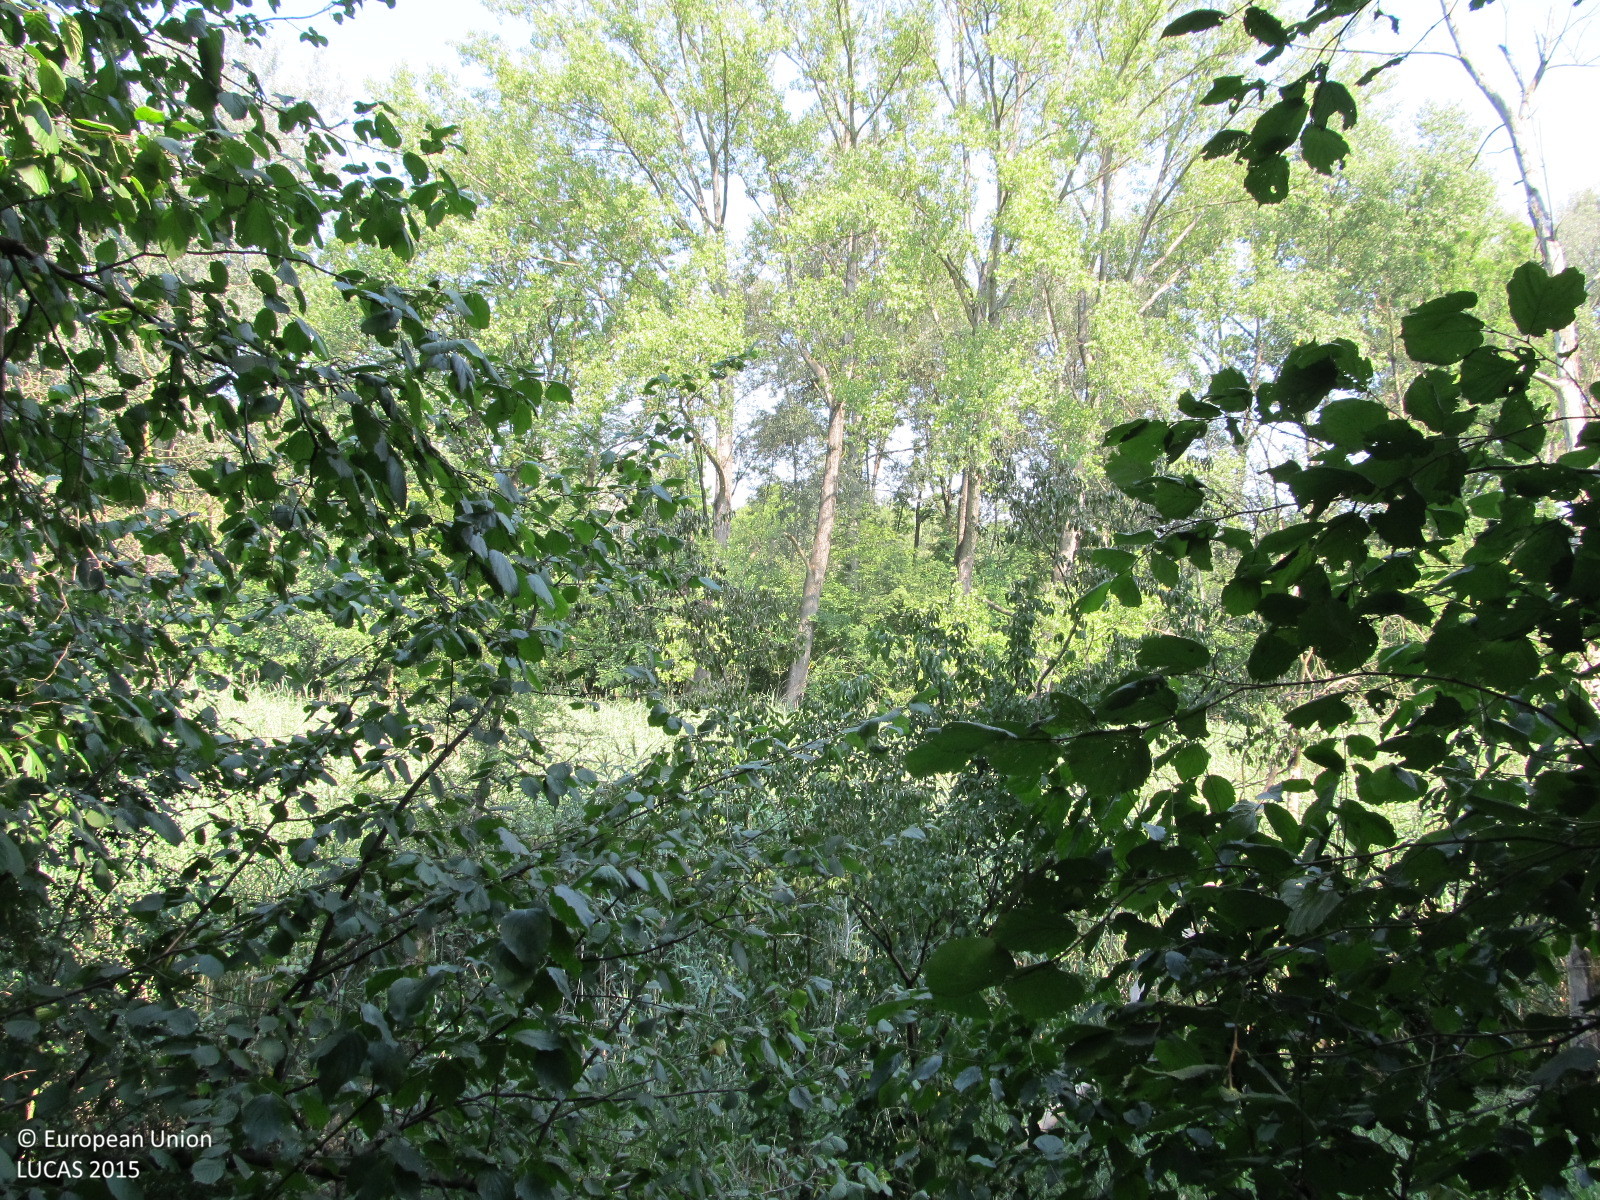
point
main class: Woodland
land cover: Broadleaved woodland
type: floodplain forest
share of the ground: > 75 %
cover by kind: broadleaved forest trees 75 %, shrubs 20 %, herbaceous plants 5 %
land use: Agriculture (excluding fallow land and kitchen gardens)
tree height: > 5 m
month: August
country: AT
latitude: 48.3556
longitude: 15.8741
